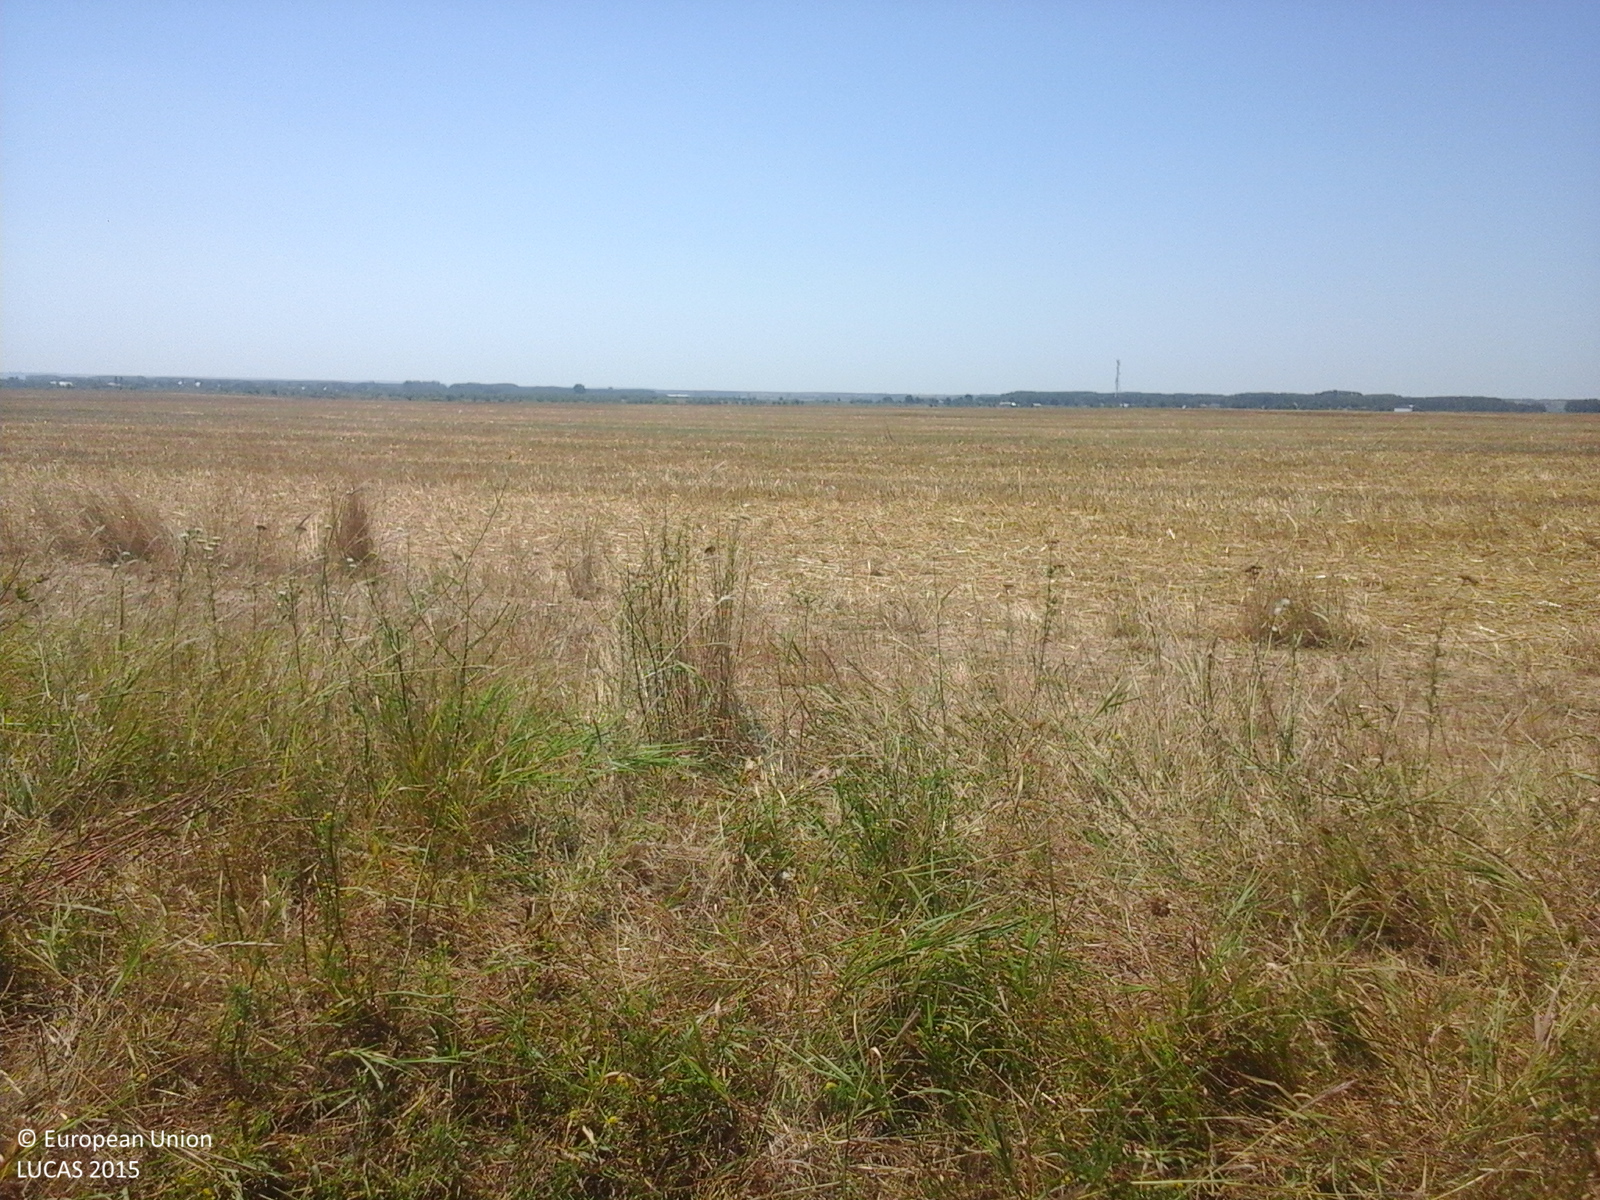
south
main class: Grassland
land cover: Spontaneously vegetated surfaces
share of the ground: > 75 %
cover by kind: herbaceous plants 100 %
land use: Fallow land
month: July
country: RO
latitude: 44.2196
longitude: 26.5746
